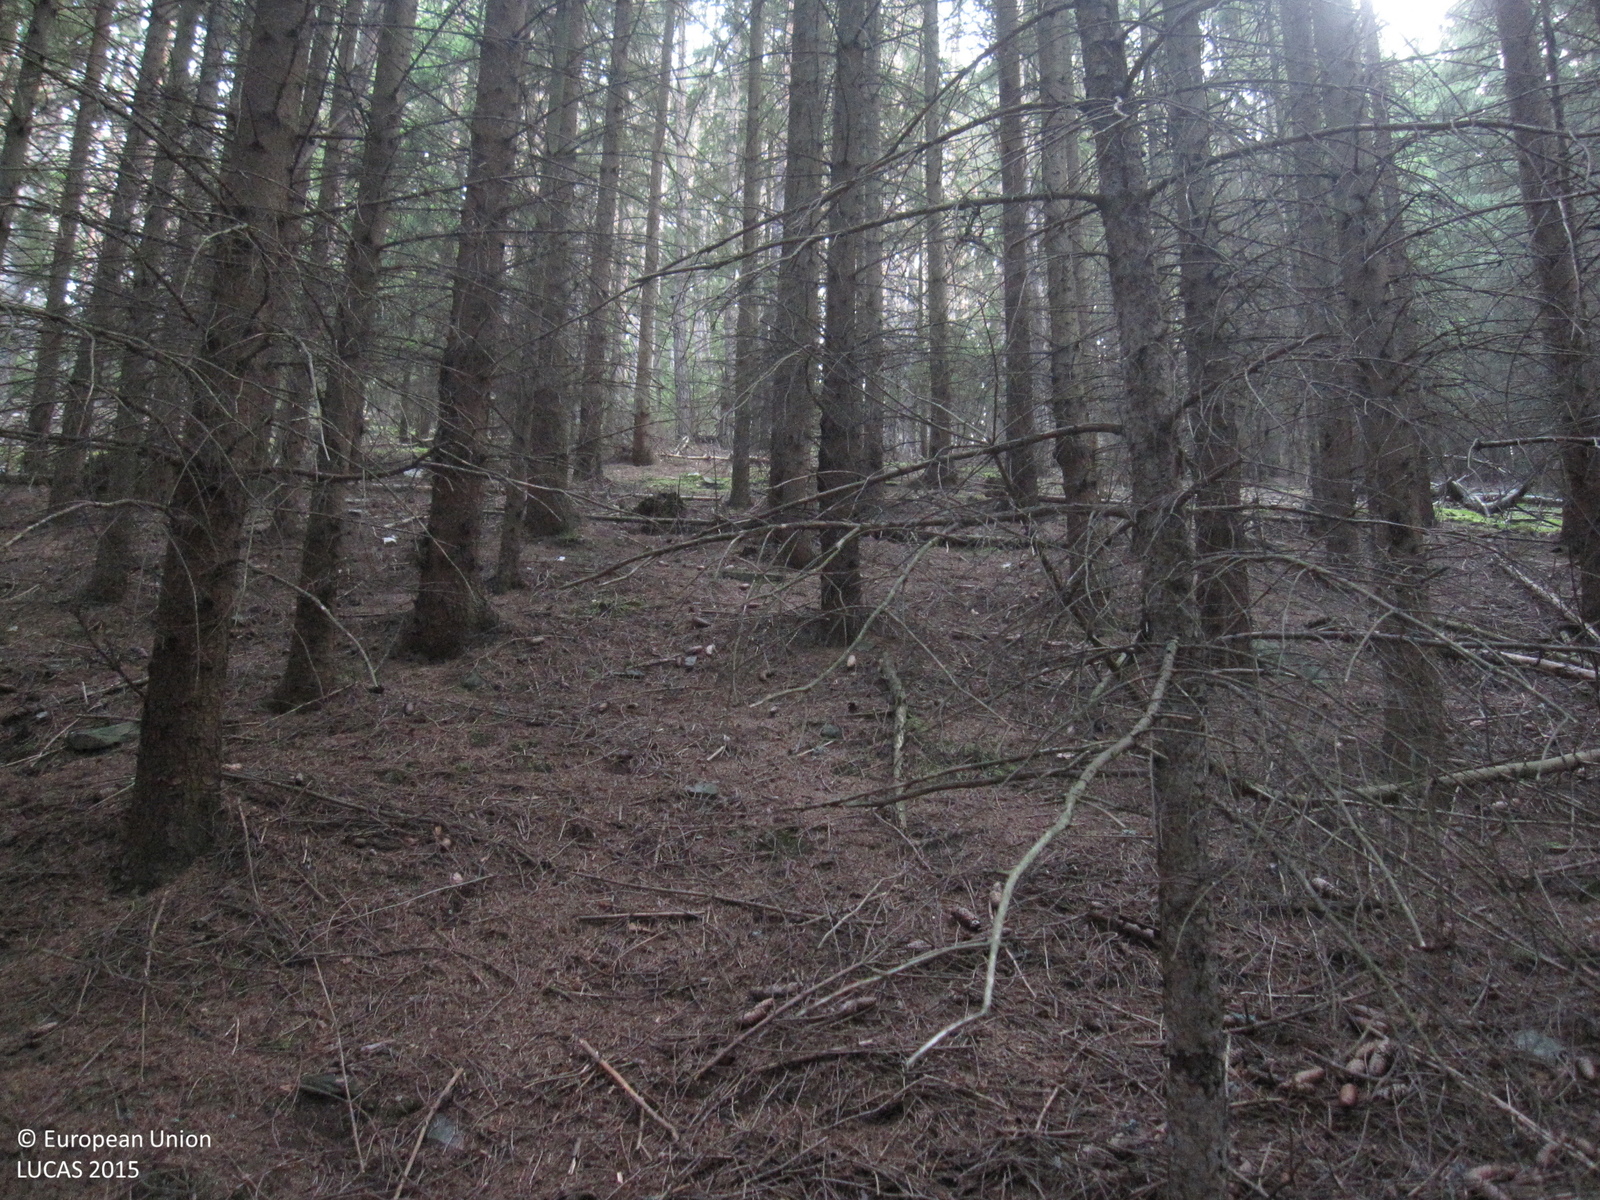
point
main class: Woodland
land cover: Spruce dominated coniferous woodland
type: hemiboreal forest and nemoral coniferous forest and mixed broadleaved-coniferous forest
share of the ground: > 75 %
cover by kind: coniferous forest trees 95 %, unconsolidated bare surface 5 %
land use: Forestry
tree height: > 5 m
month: August
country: DE
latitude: 50.5347
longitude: 11.4528
